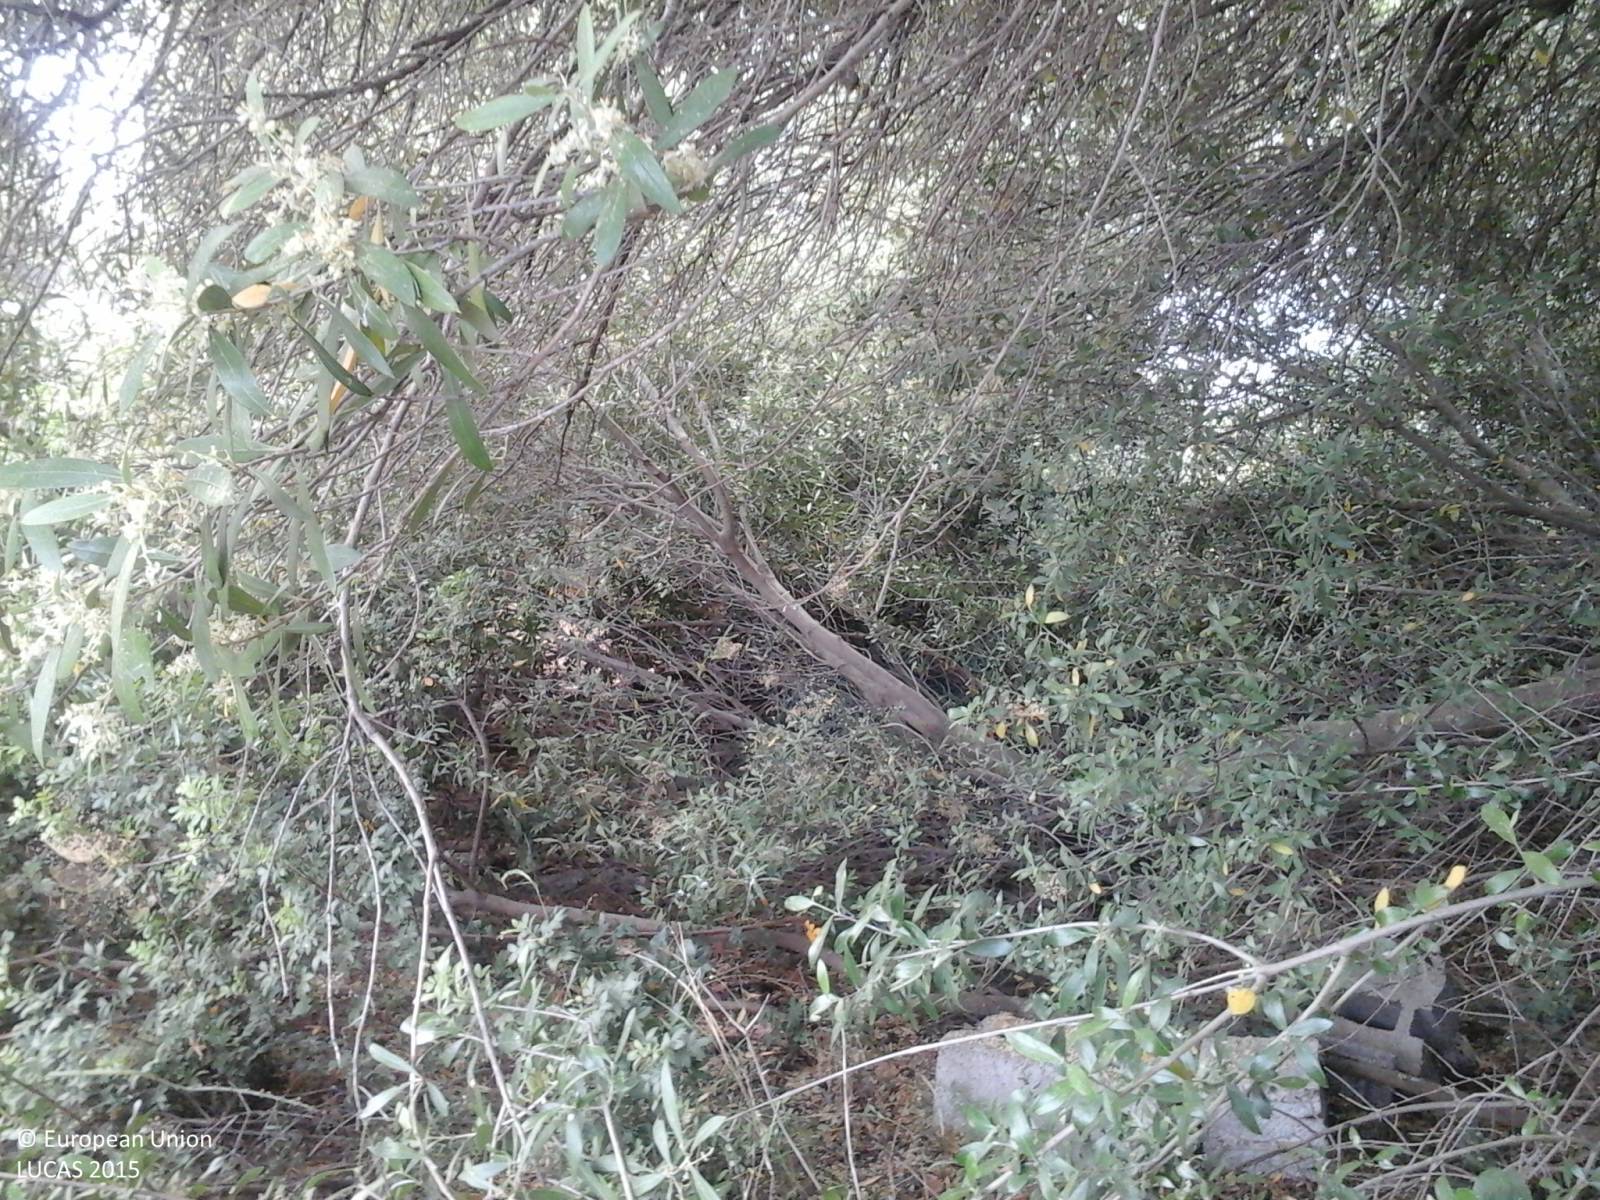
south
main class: Woodland
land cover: Broadleaved woodland
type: broadleaved evergreen forest
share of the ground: > 75 %
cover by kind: broadleaved forest trees 45 %, shrubs 45 %
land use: Amenities, museums, leisure
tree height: > 5 m
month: May
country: IT
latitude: 40.9667
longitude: 8.8764
